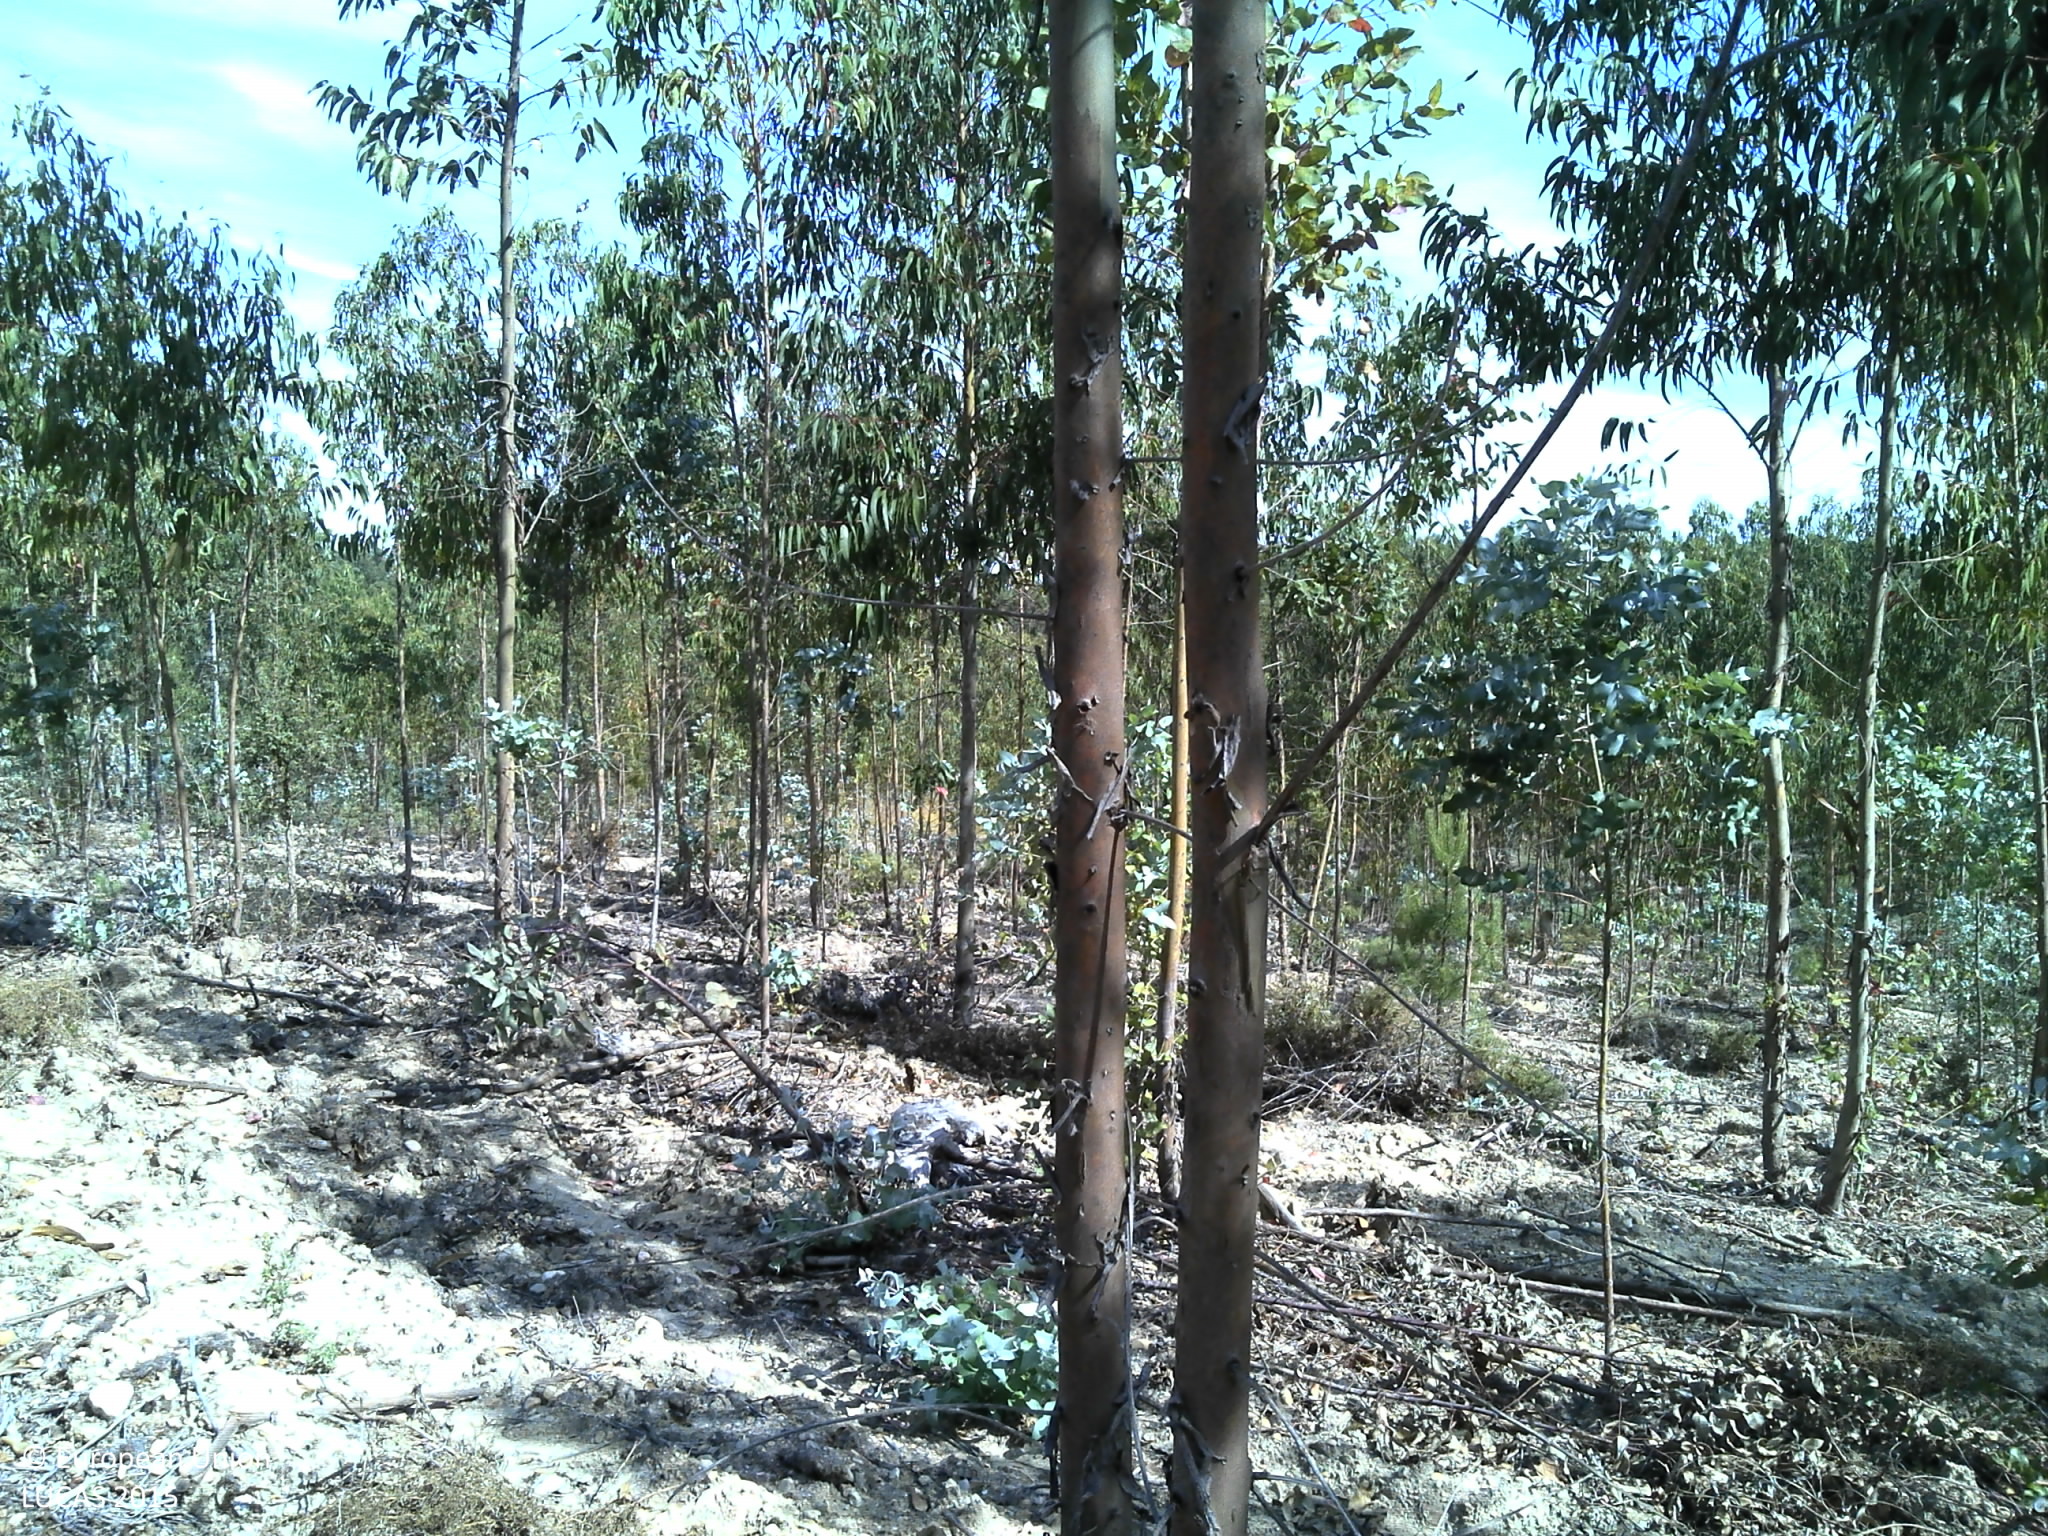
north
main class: Woodland
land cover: Broadleaved woodland
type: exotic forest
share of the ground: 50 - 75 %
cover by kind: broadleaved forest trees 50 %, unconsolidated bare surface 50 %
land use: Forestry
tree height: > 5 m
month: May
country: PT
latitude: 39.2776
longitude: -7.9640
